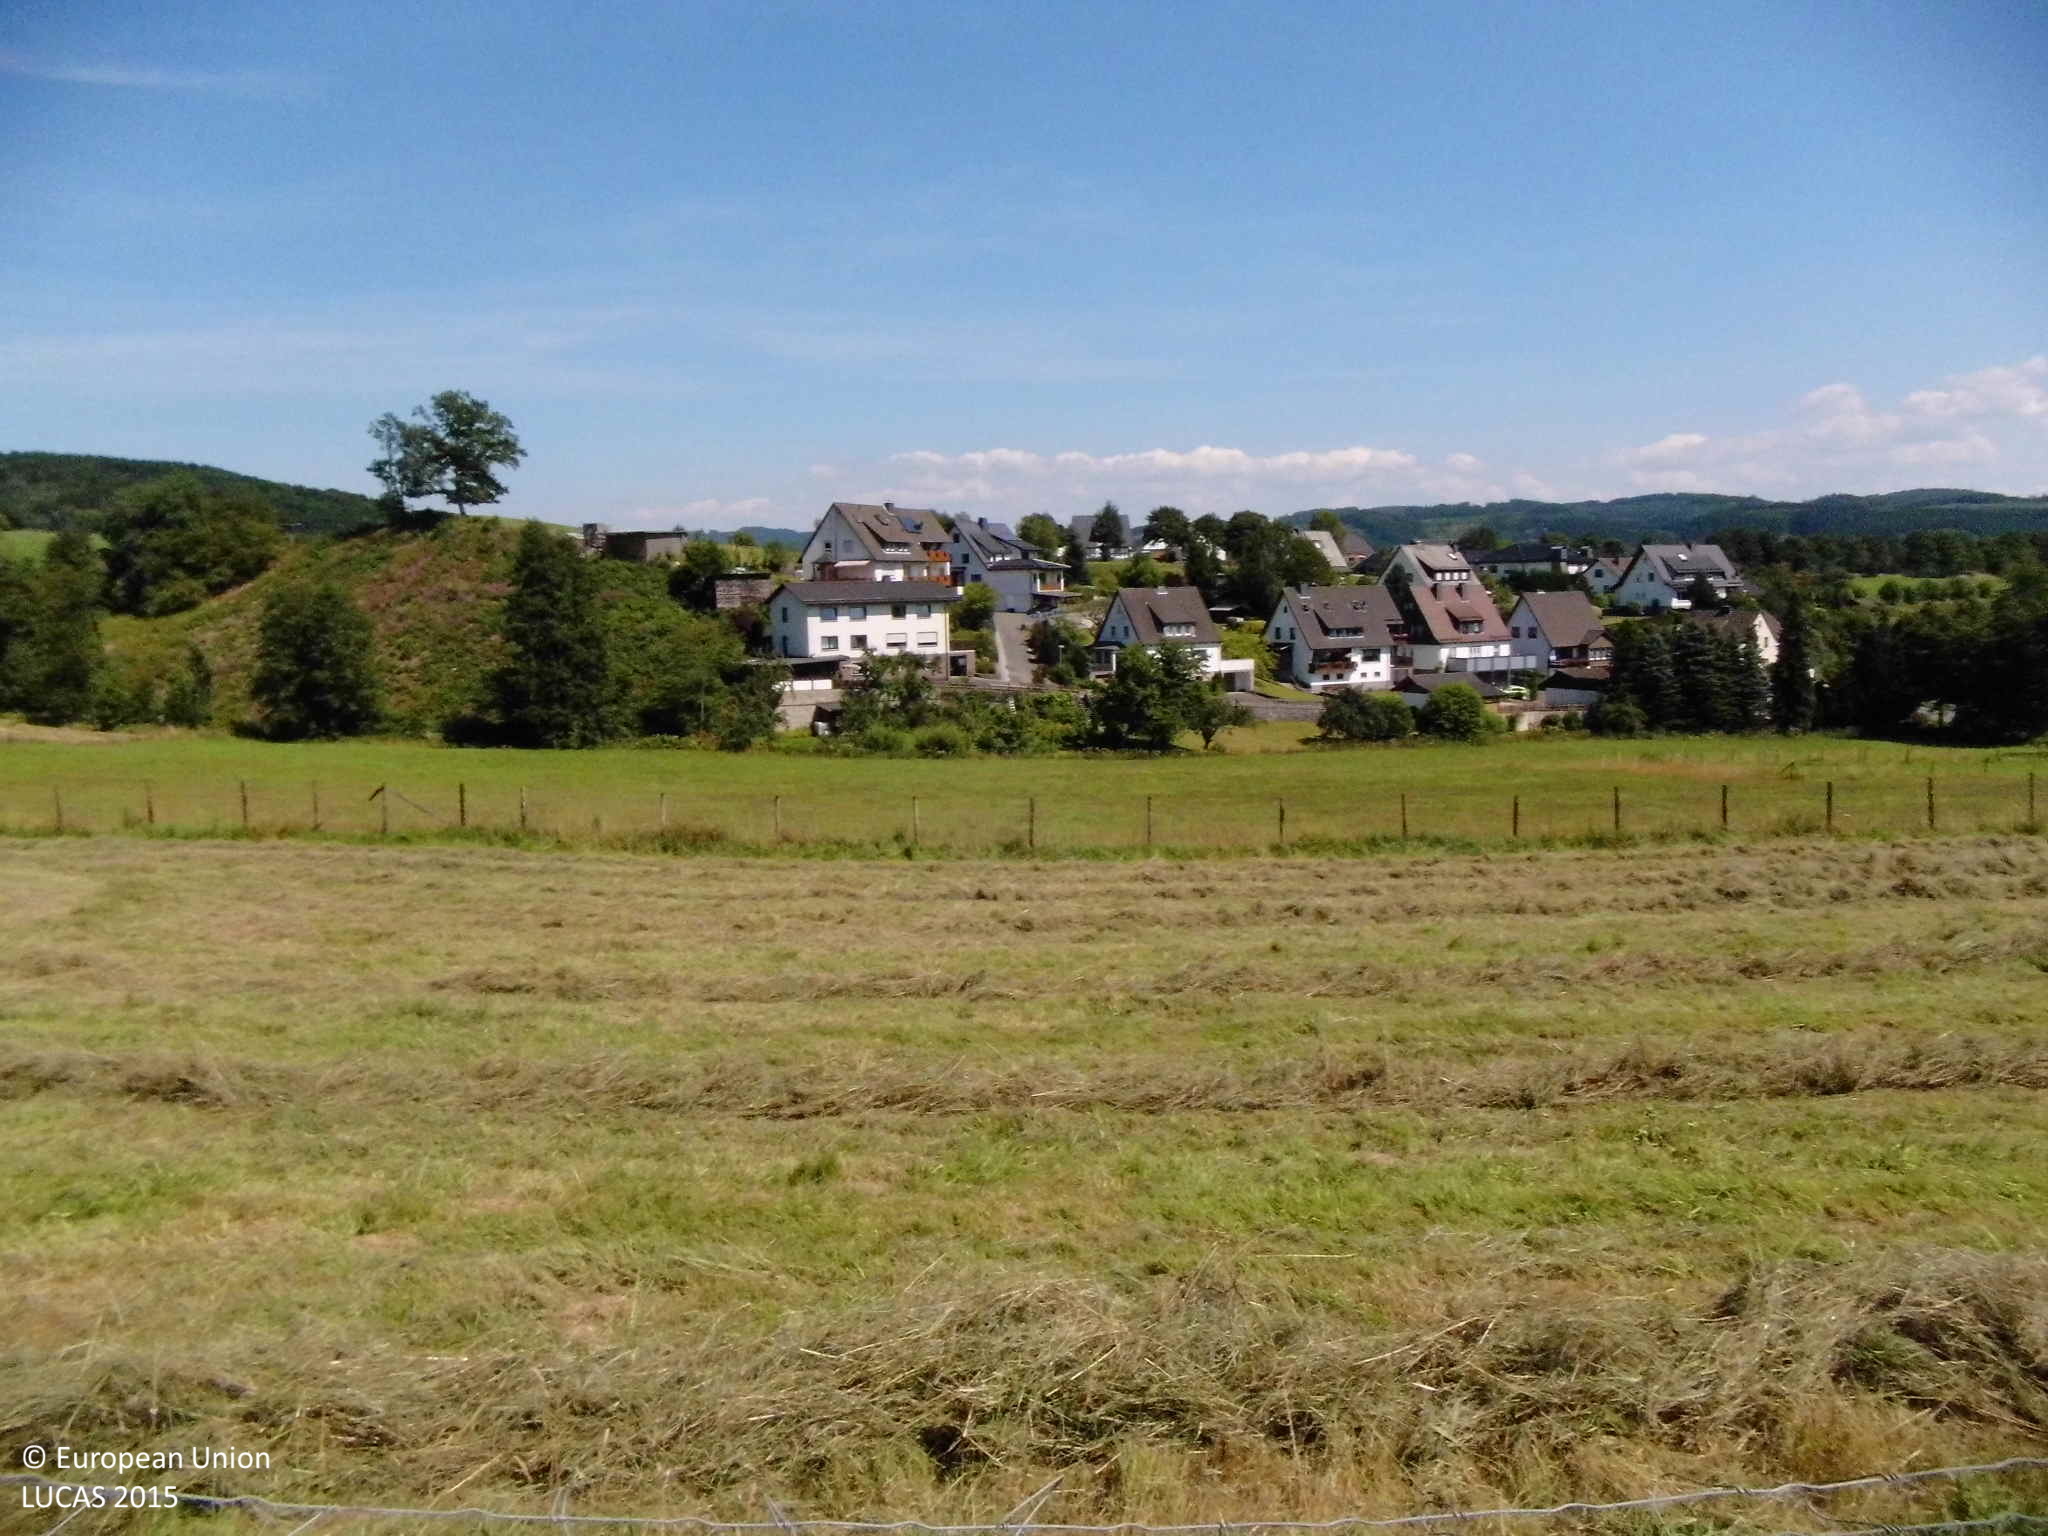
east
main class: Grassland
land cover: Grassland without tree/shrub cover
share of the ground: > 75 %
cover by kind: herbaceous plants 100 %
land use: Agriculture (excluding fallow land and kitchen gardens)
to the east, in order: Grassland without tree/shrub cover; Fences; Grassland without tree/shrub cover; Fences; Grassland without tree/shrub cover; Fences; Ditches and canals; Grassland with sparse tree/shrub cover; Artificial constructions in urban areas
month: August
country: DE
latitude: 51.1921
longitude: 8.0114
